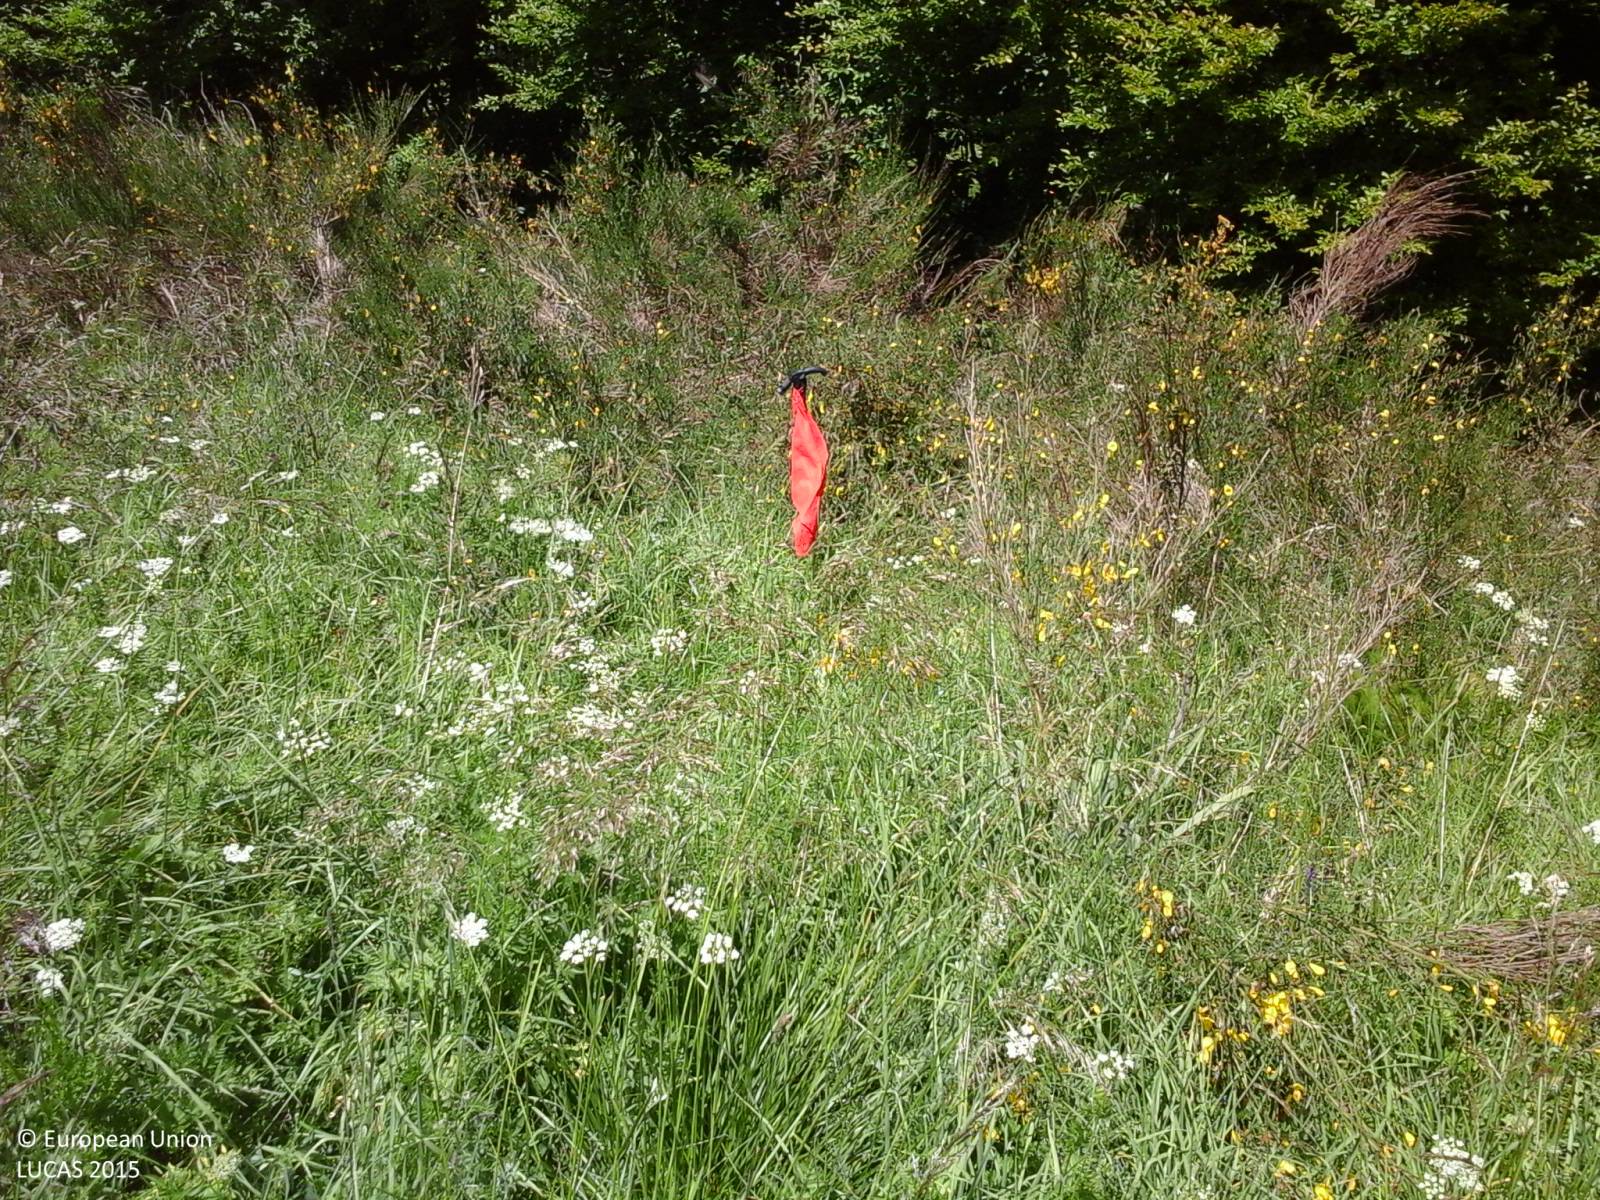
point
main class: Shrubland
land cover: Shrubland without tree cover
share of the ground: > 75 %
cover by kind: herbaceous plants 80 %, shrubs 20 %
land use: Semi-natural and natural areas not in use
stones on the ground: < 10 %
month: September
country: IT
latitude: 42.5801
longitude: 13.3647
